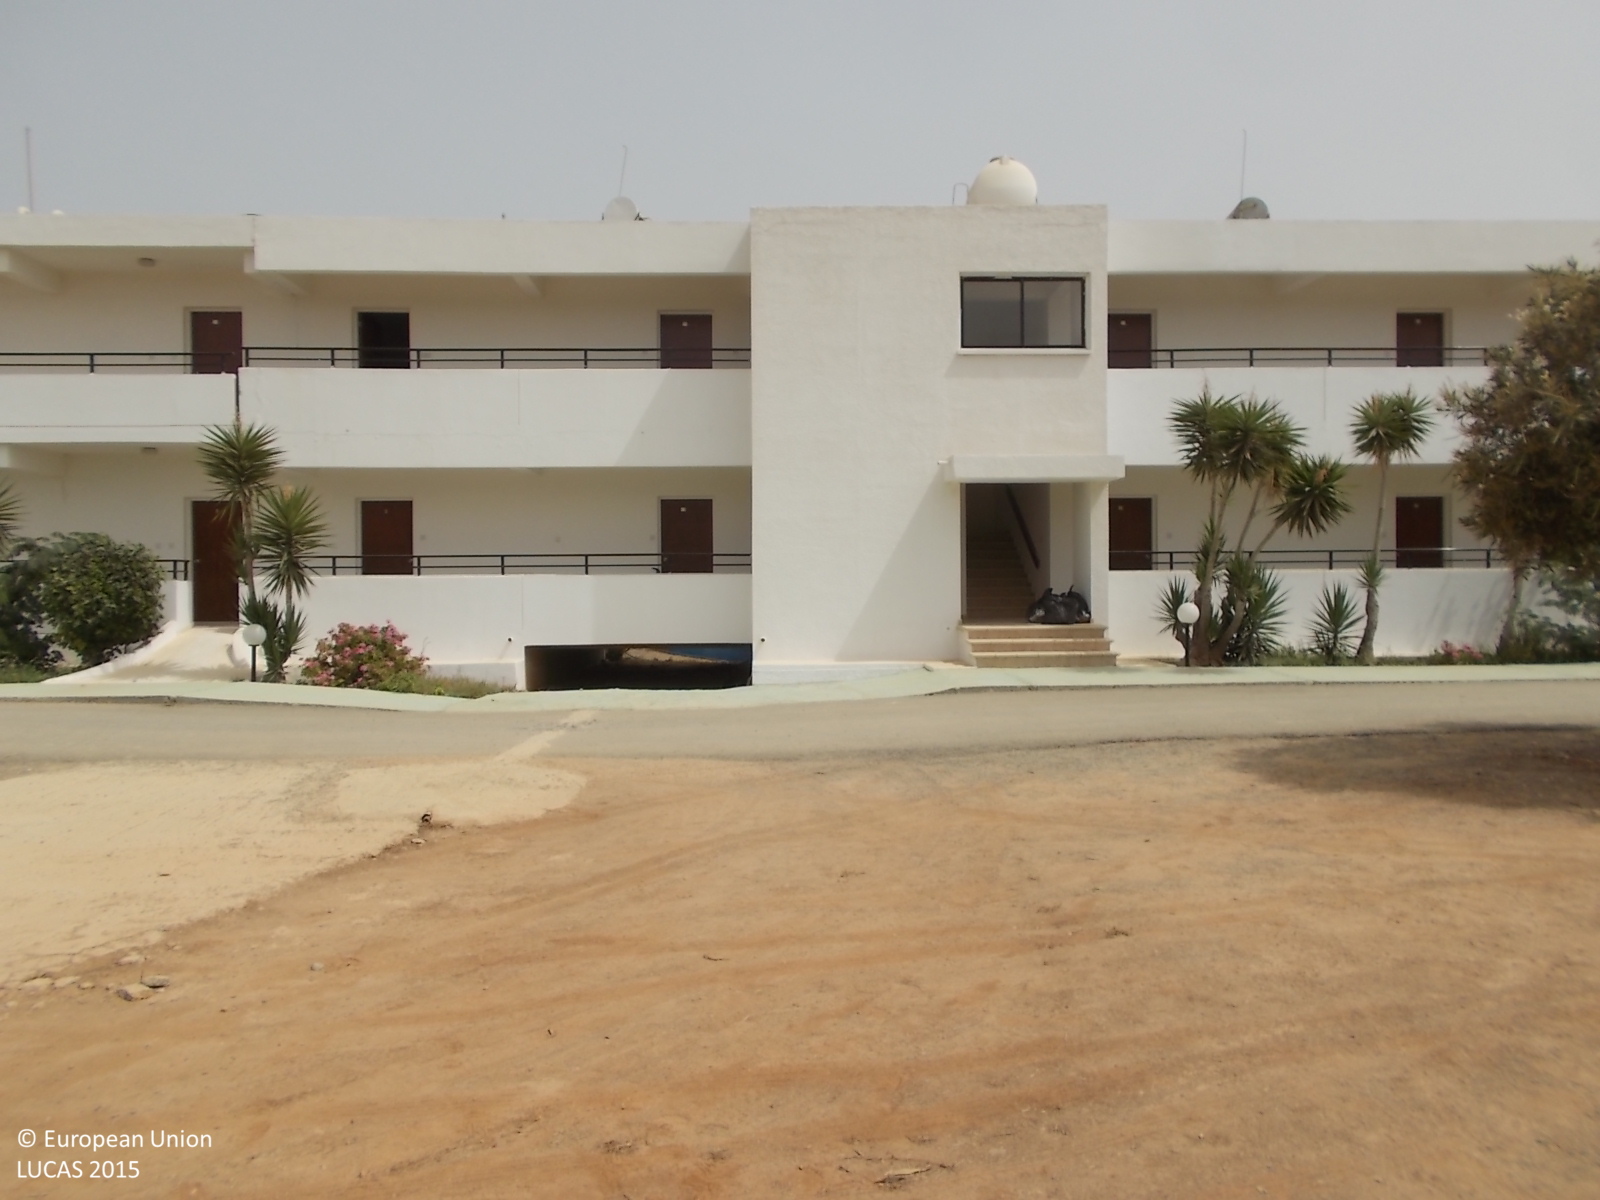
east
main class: Cropland
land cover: Olive groves
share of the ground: > 75 %
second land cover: Other bare soil
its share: > 75 %
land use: Agriculture (excluding fallow land and kitchen gardens)
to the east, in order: Olive groves; Other bare soil; Artificial constructions in urban areas; Grassland with sparse tree/shrub cover; Tracks; Grassland with sparse tree/shrub cover; Other mixed woodland
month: March
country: CY
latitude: 34.9845
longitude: 34.0658
